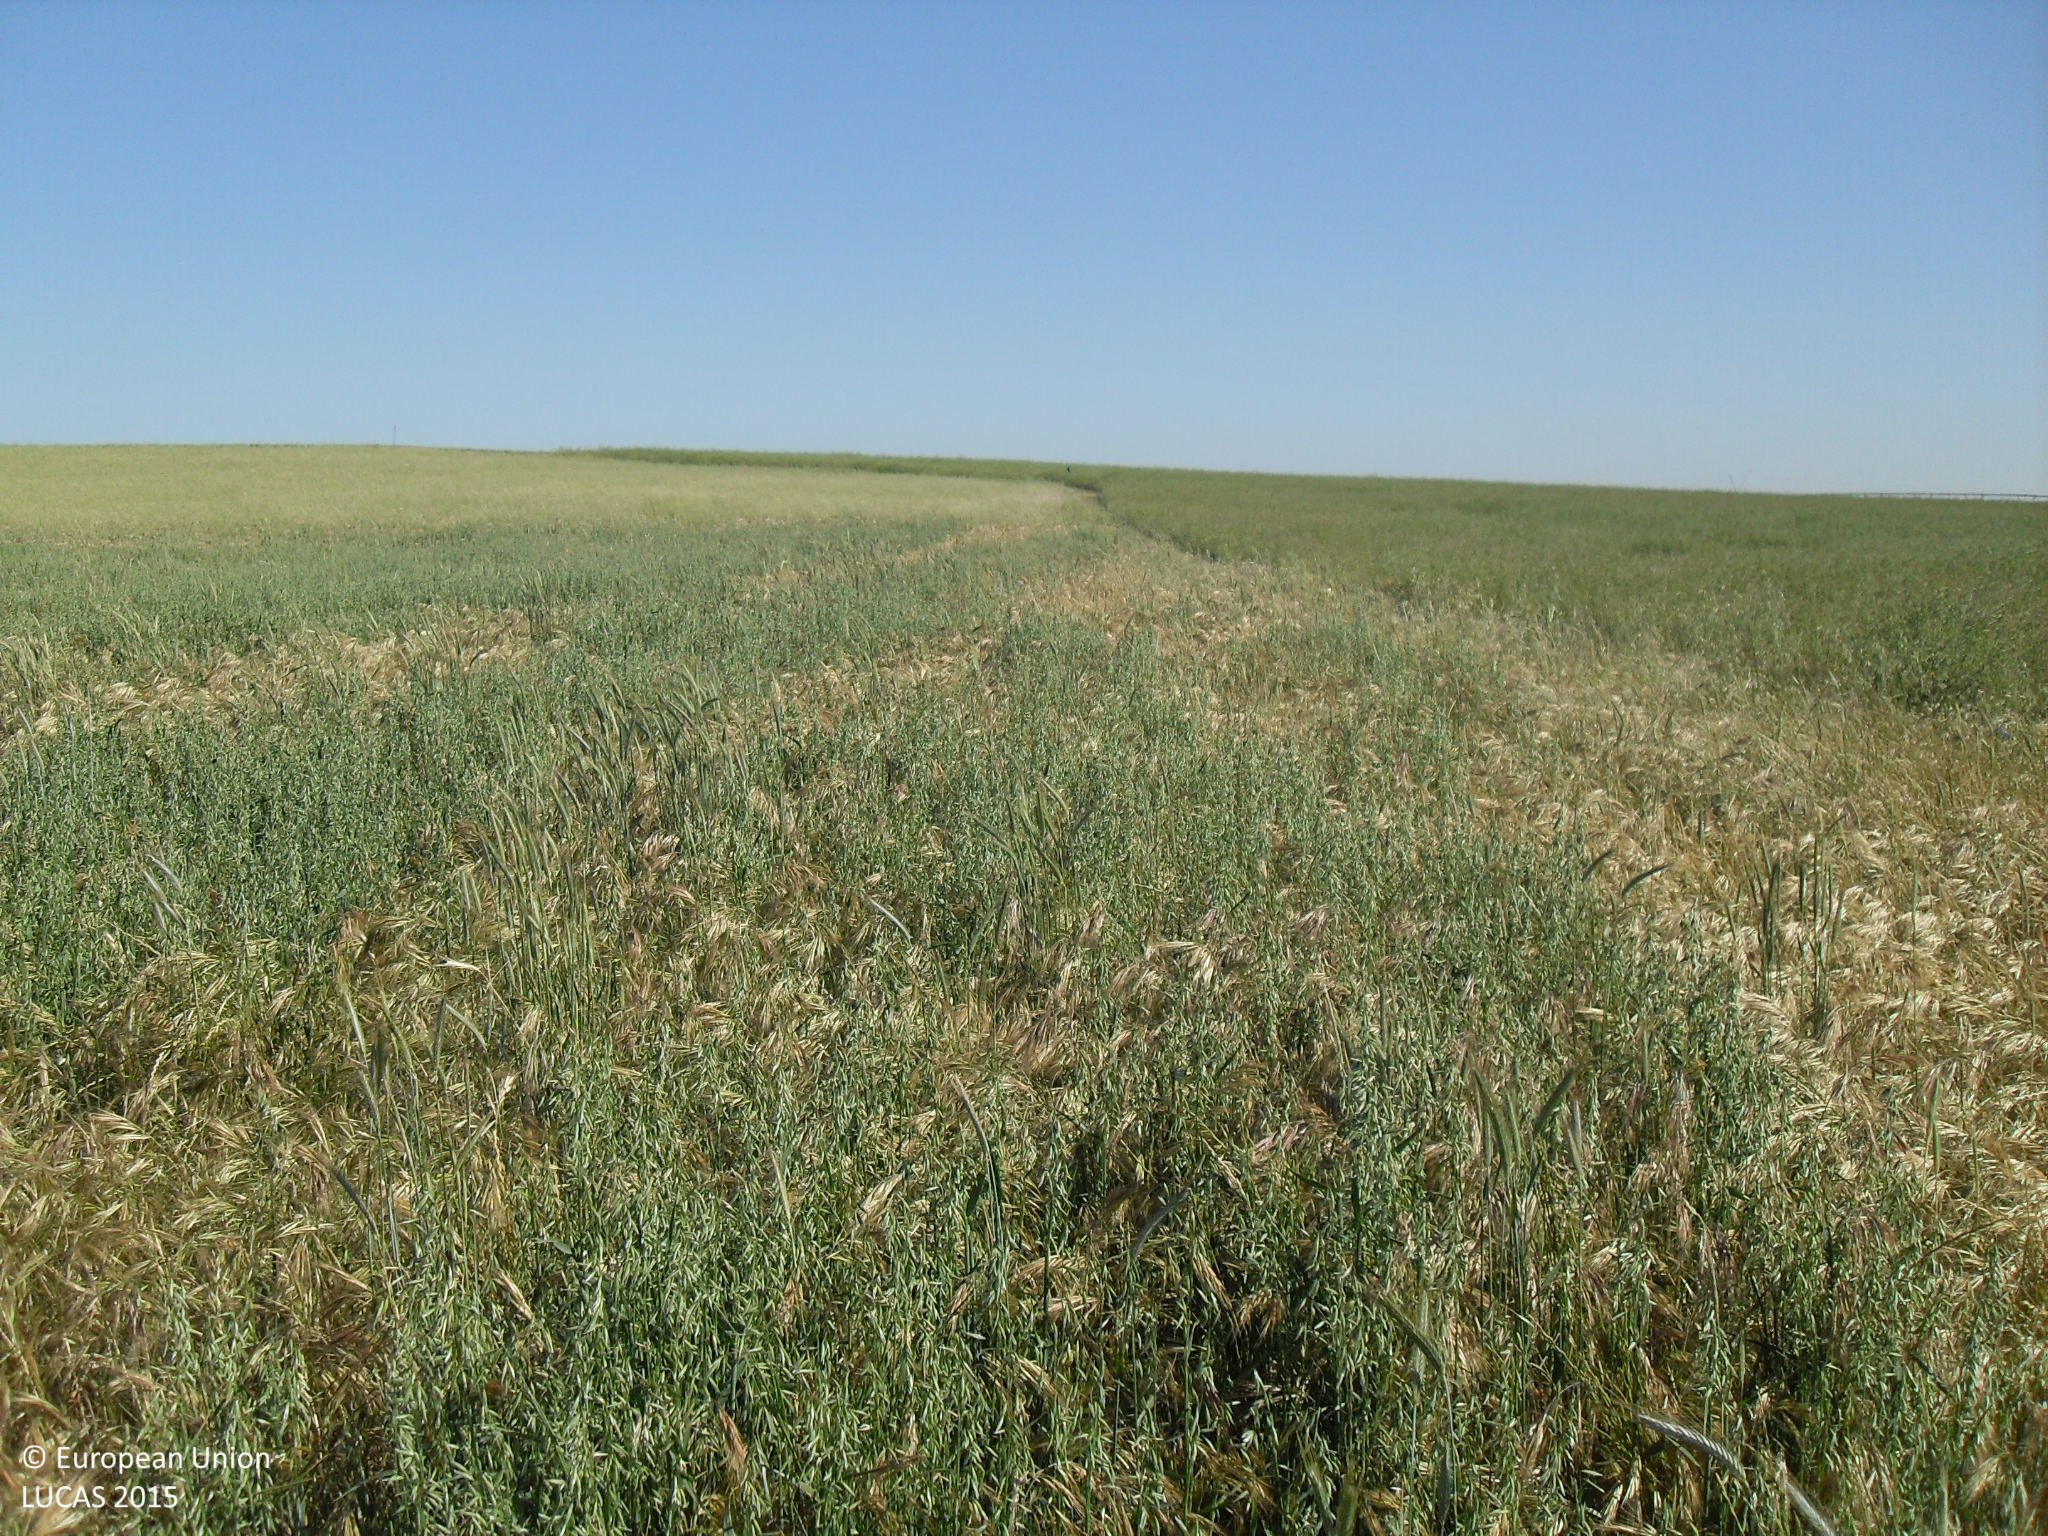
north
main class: Cropland
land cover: Oats
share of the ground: > 75 %
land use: Agriculture (excluding fallow land and kitchen gardens)
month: May
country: ES
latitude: 41.0524
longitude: -5.2403
